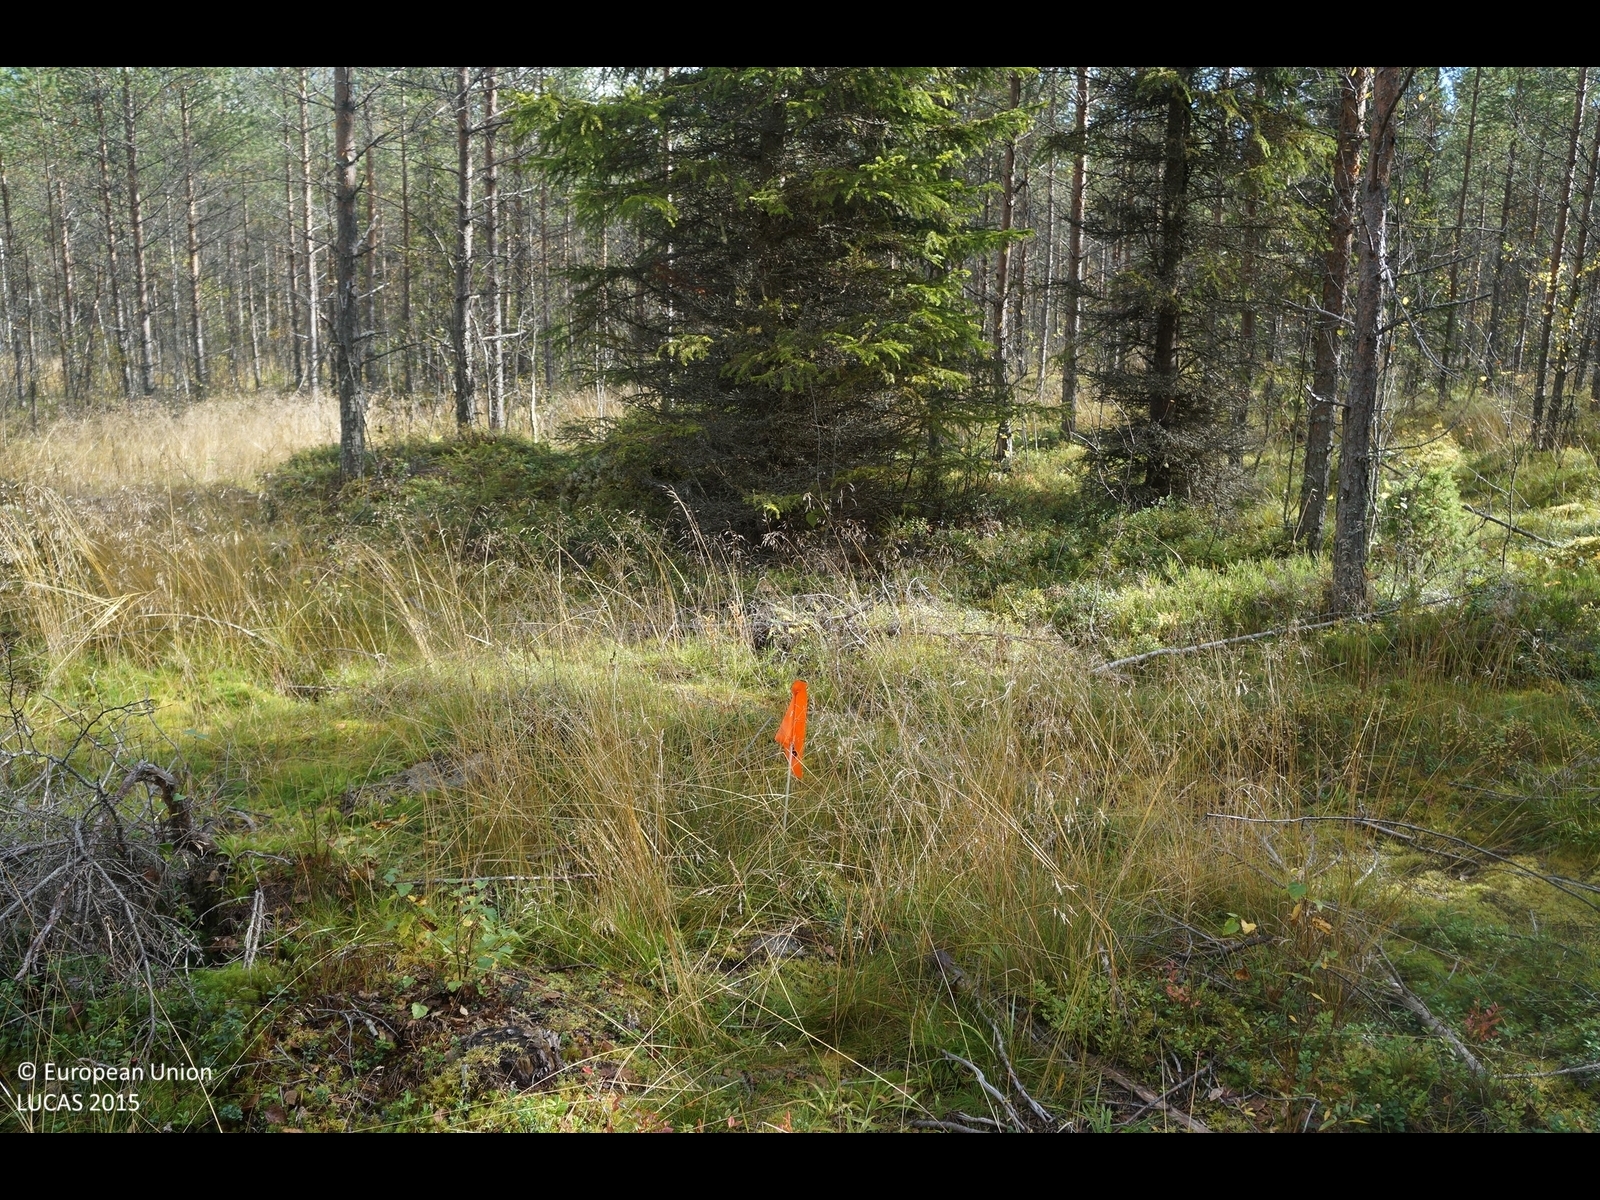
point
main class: Woodland
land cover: Pine dominated coniferous woodland
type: boreal forest
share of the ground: 50 - 75 %
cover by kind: coniferous forest trees 50 %, shrubs 20 %, lichens and mosses 20 %, herbaceous plants 10 %
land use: Forestry
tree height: > 5 m
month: September
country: FI
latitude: 64.4969
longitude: 24.7494
